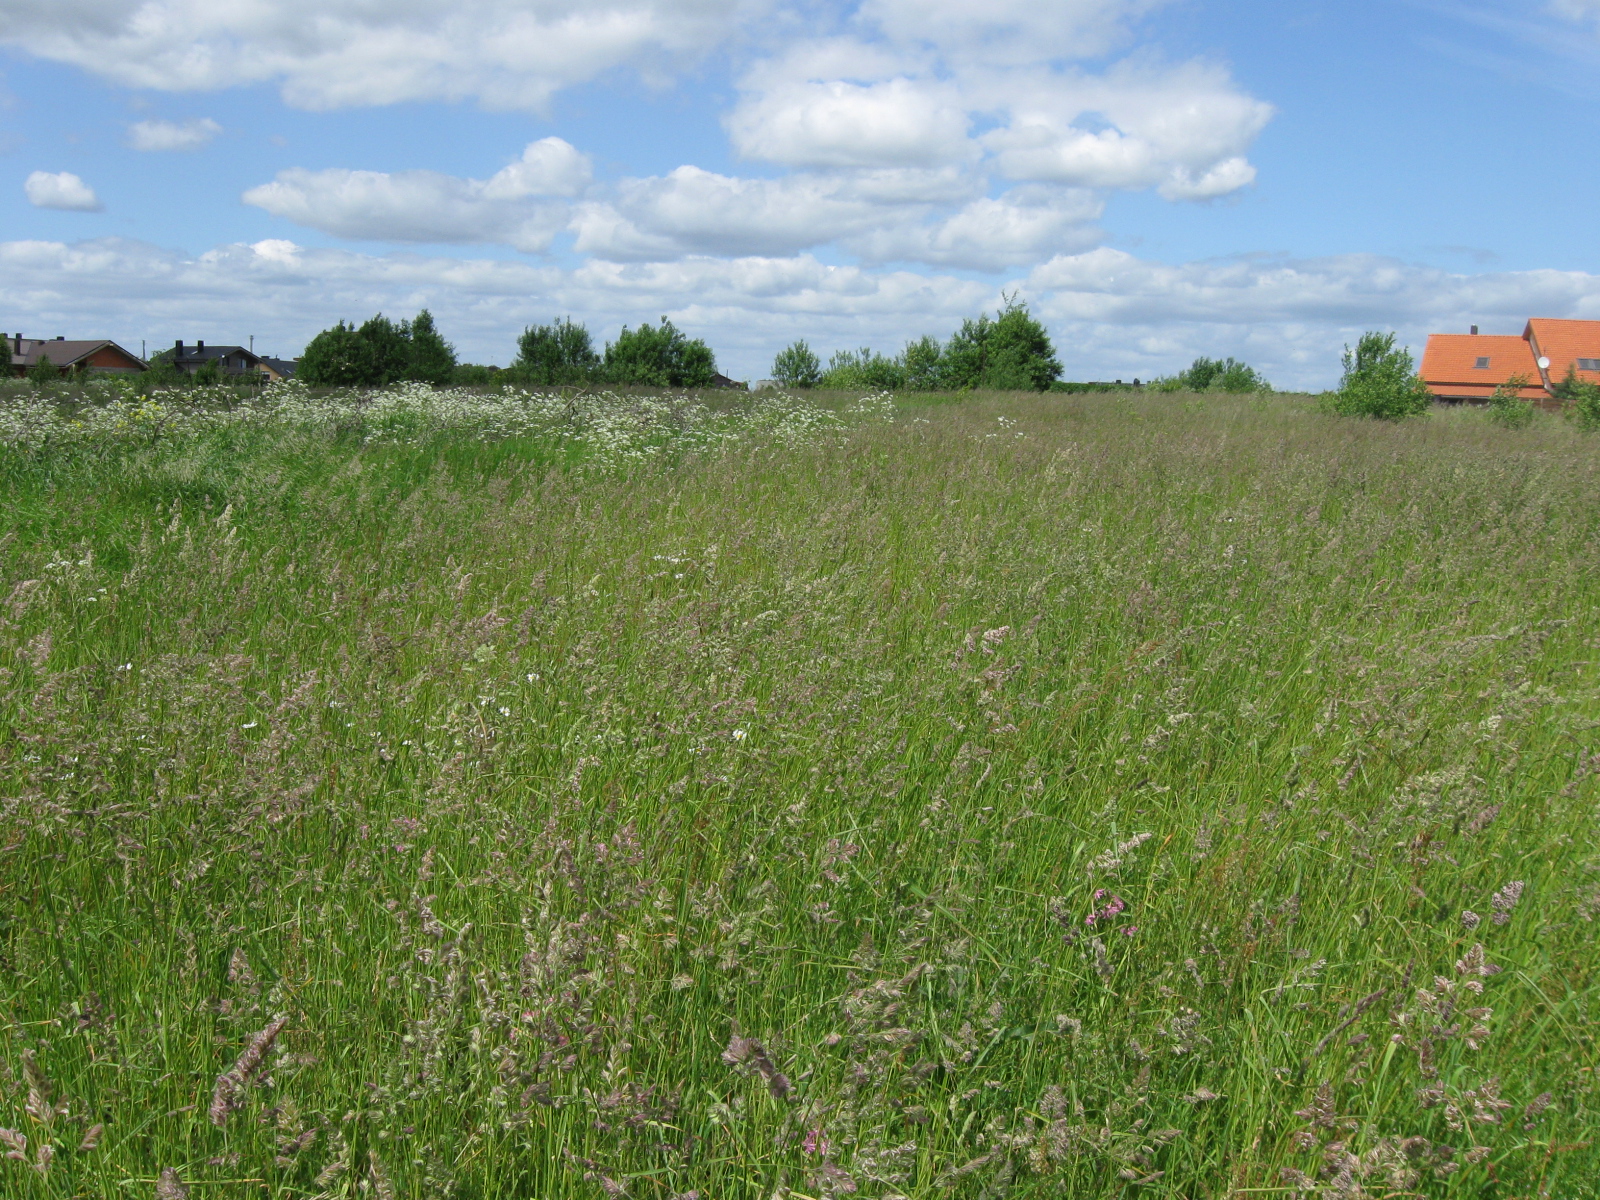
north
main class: Grassland
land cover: Grassland without tree/shrub cover
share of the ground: > 75 %
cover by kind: herbaceous plants 100 %
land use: Agriculture (excluding fallow land and kitchen gardens)
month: June
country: LT
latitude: 54.9606
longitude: 23.8150
